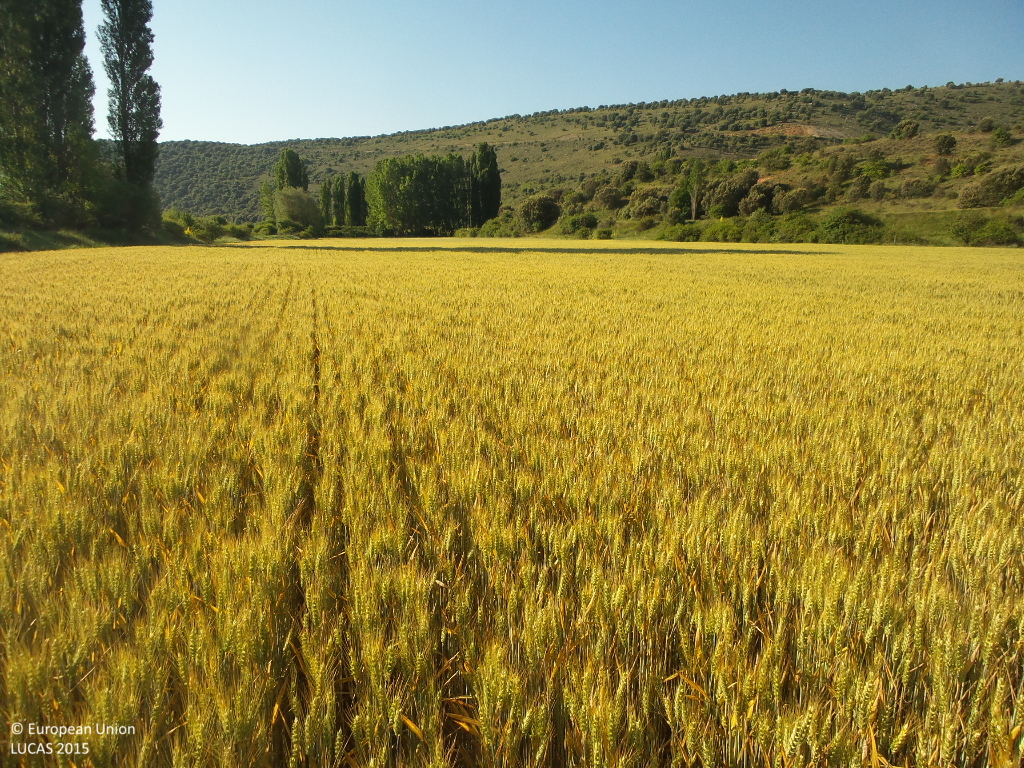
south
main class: Cropland
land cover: Common wheat
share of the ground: > 75 %
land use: Agriculture (excluding fallow land and kitchen gardens)
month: June
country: ES
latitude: 41.3733
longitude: -2.7222
